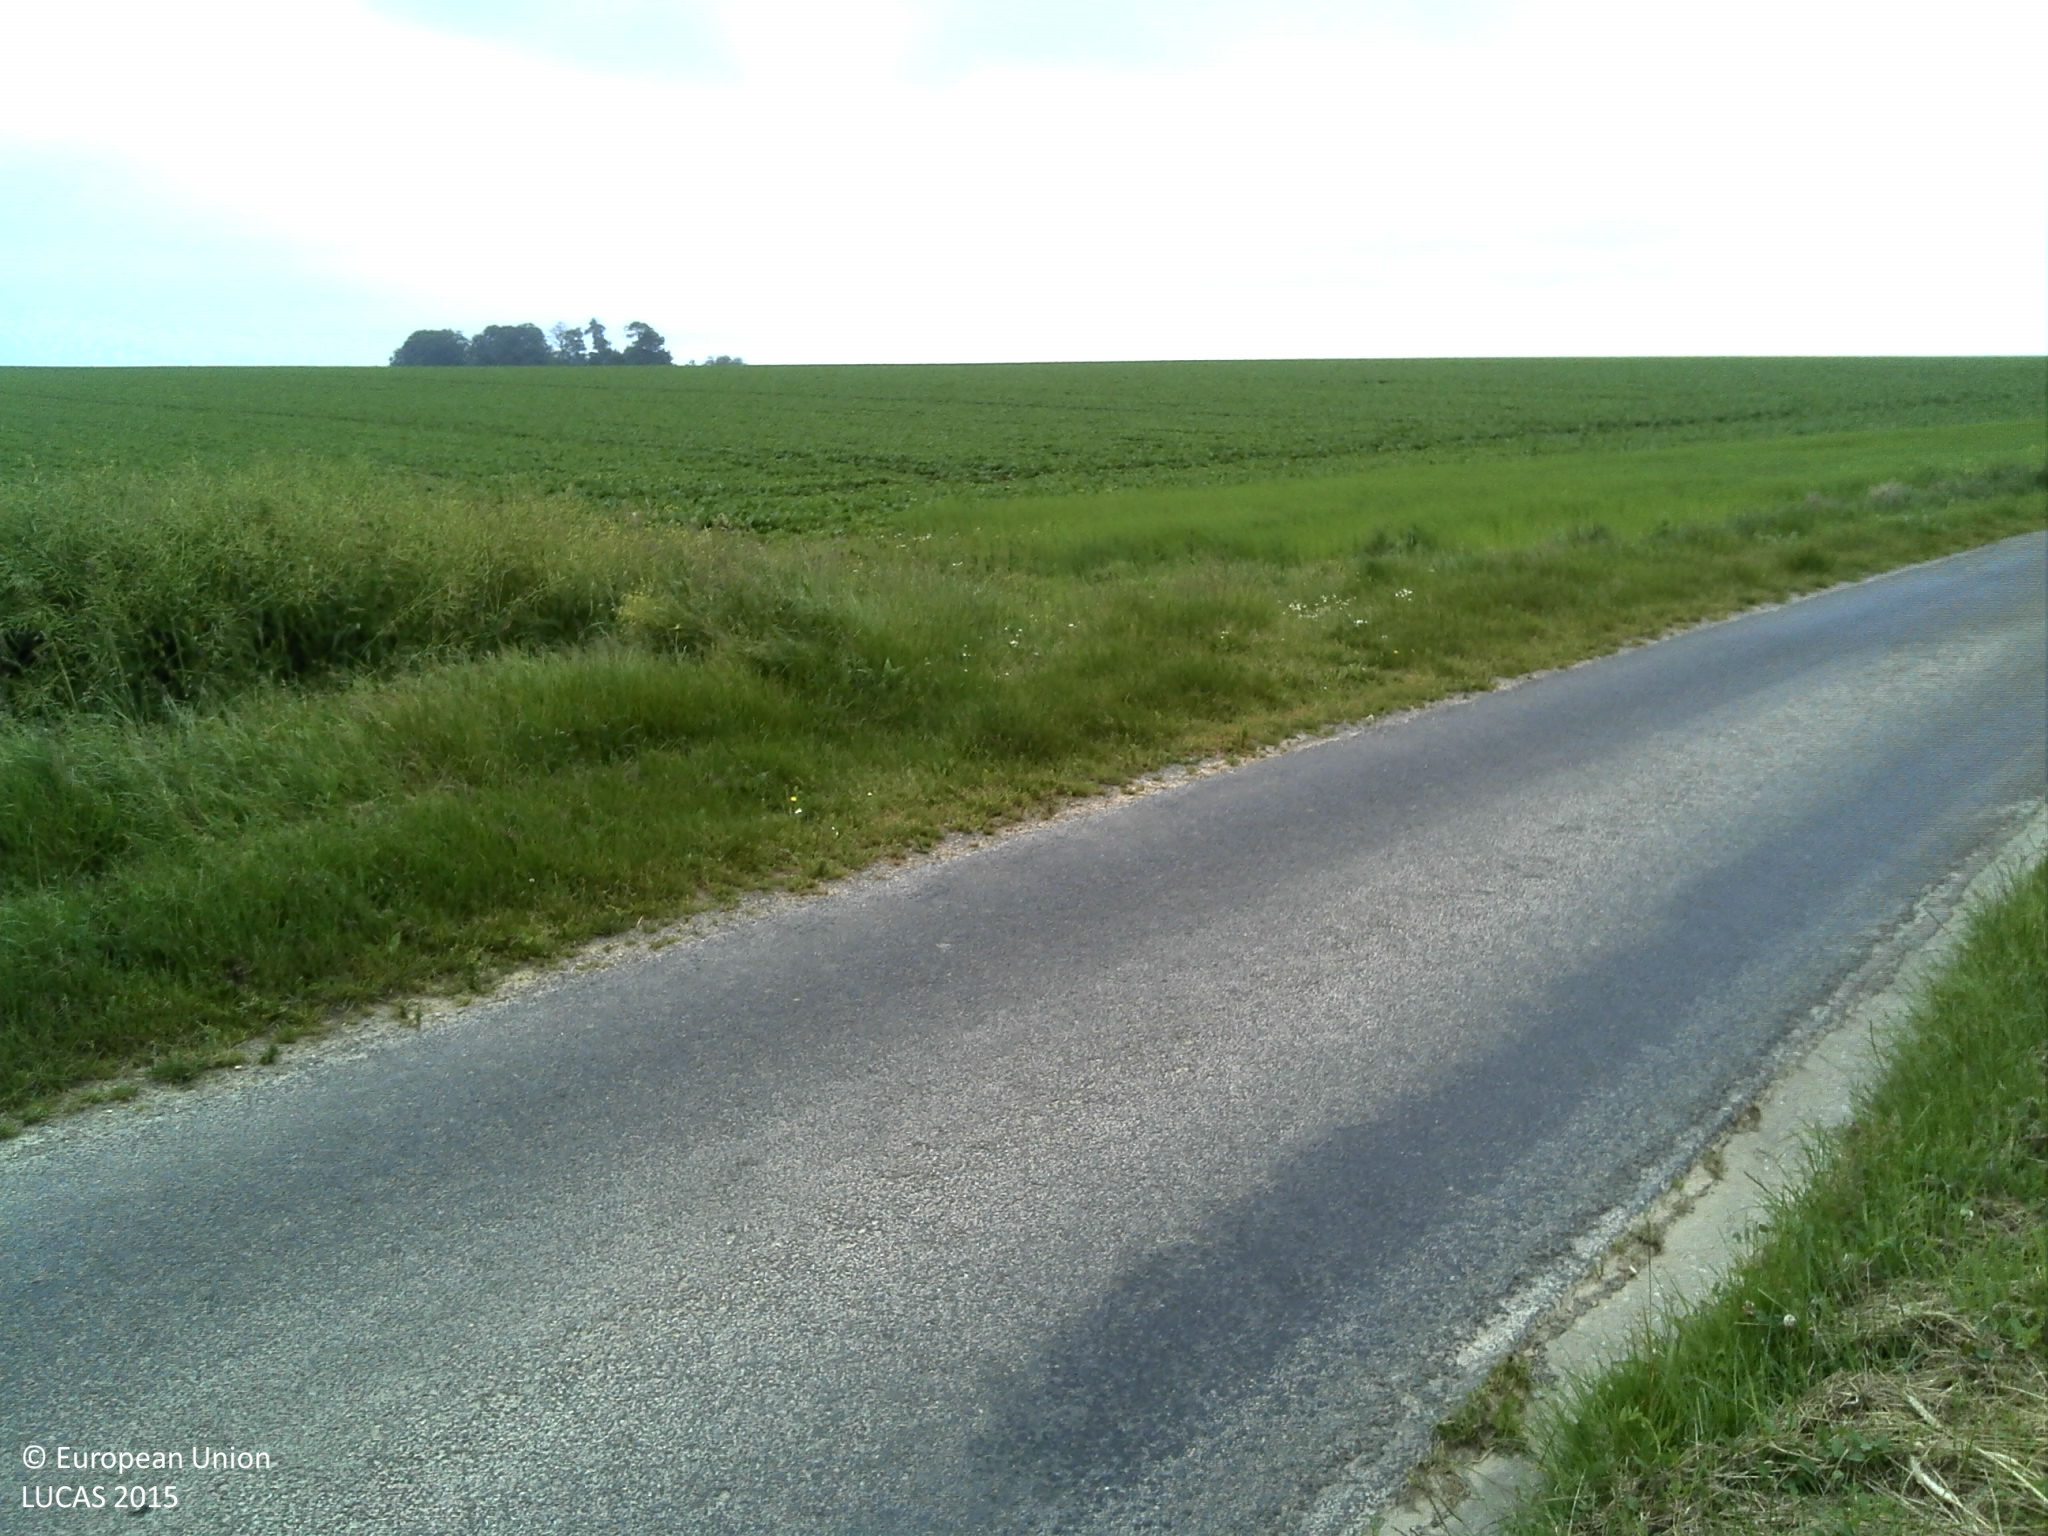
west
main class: Cropland
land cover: Rape and turnip rape
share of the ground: > 75 %
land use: Agriculture (excluding fallow land and kitchen gardens)
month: June
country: FR
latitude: 49.6624
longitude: 0.3151
